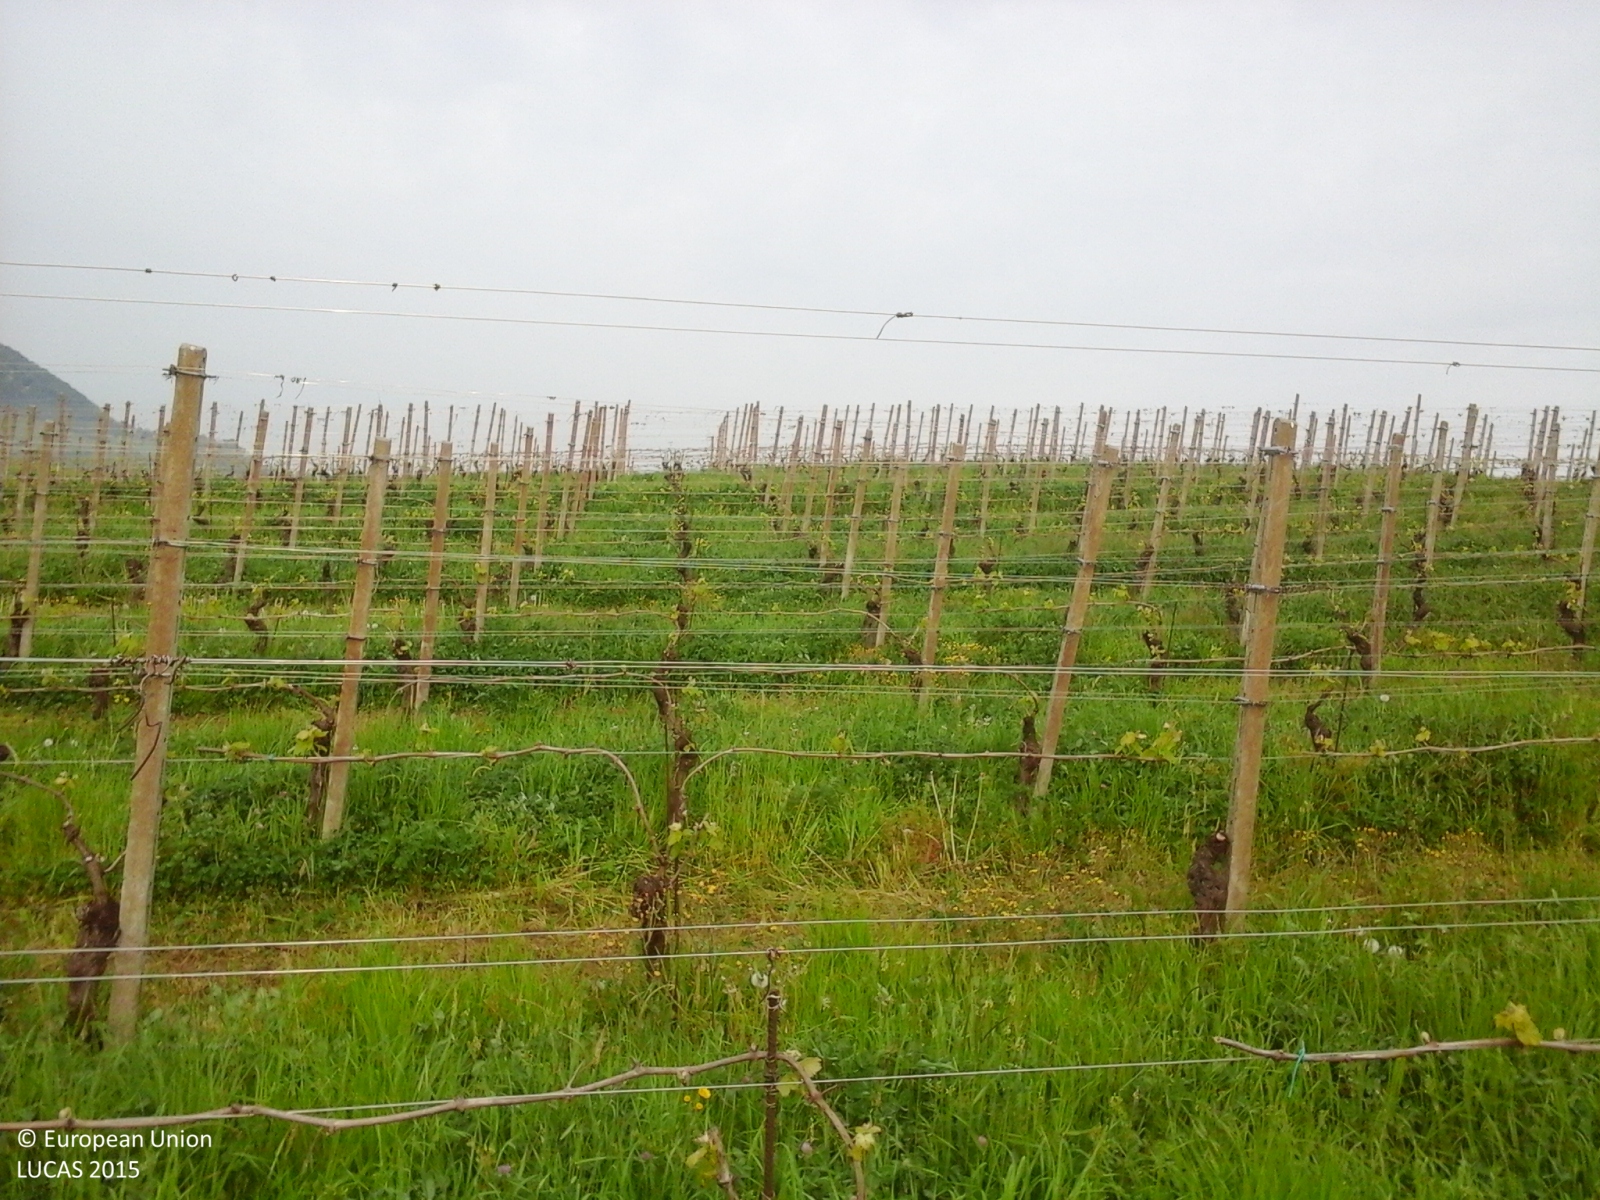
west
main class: Cropland
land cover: Vineyards
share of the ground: < 10 %
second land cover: Grassland without tree/shrub cover
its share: > 75 %
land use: Agriculture (excluding fallow land and kitchen gardens)
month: April
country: IT
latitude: 44.9618
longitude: 9.3800
